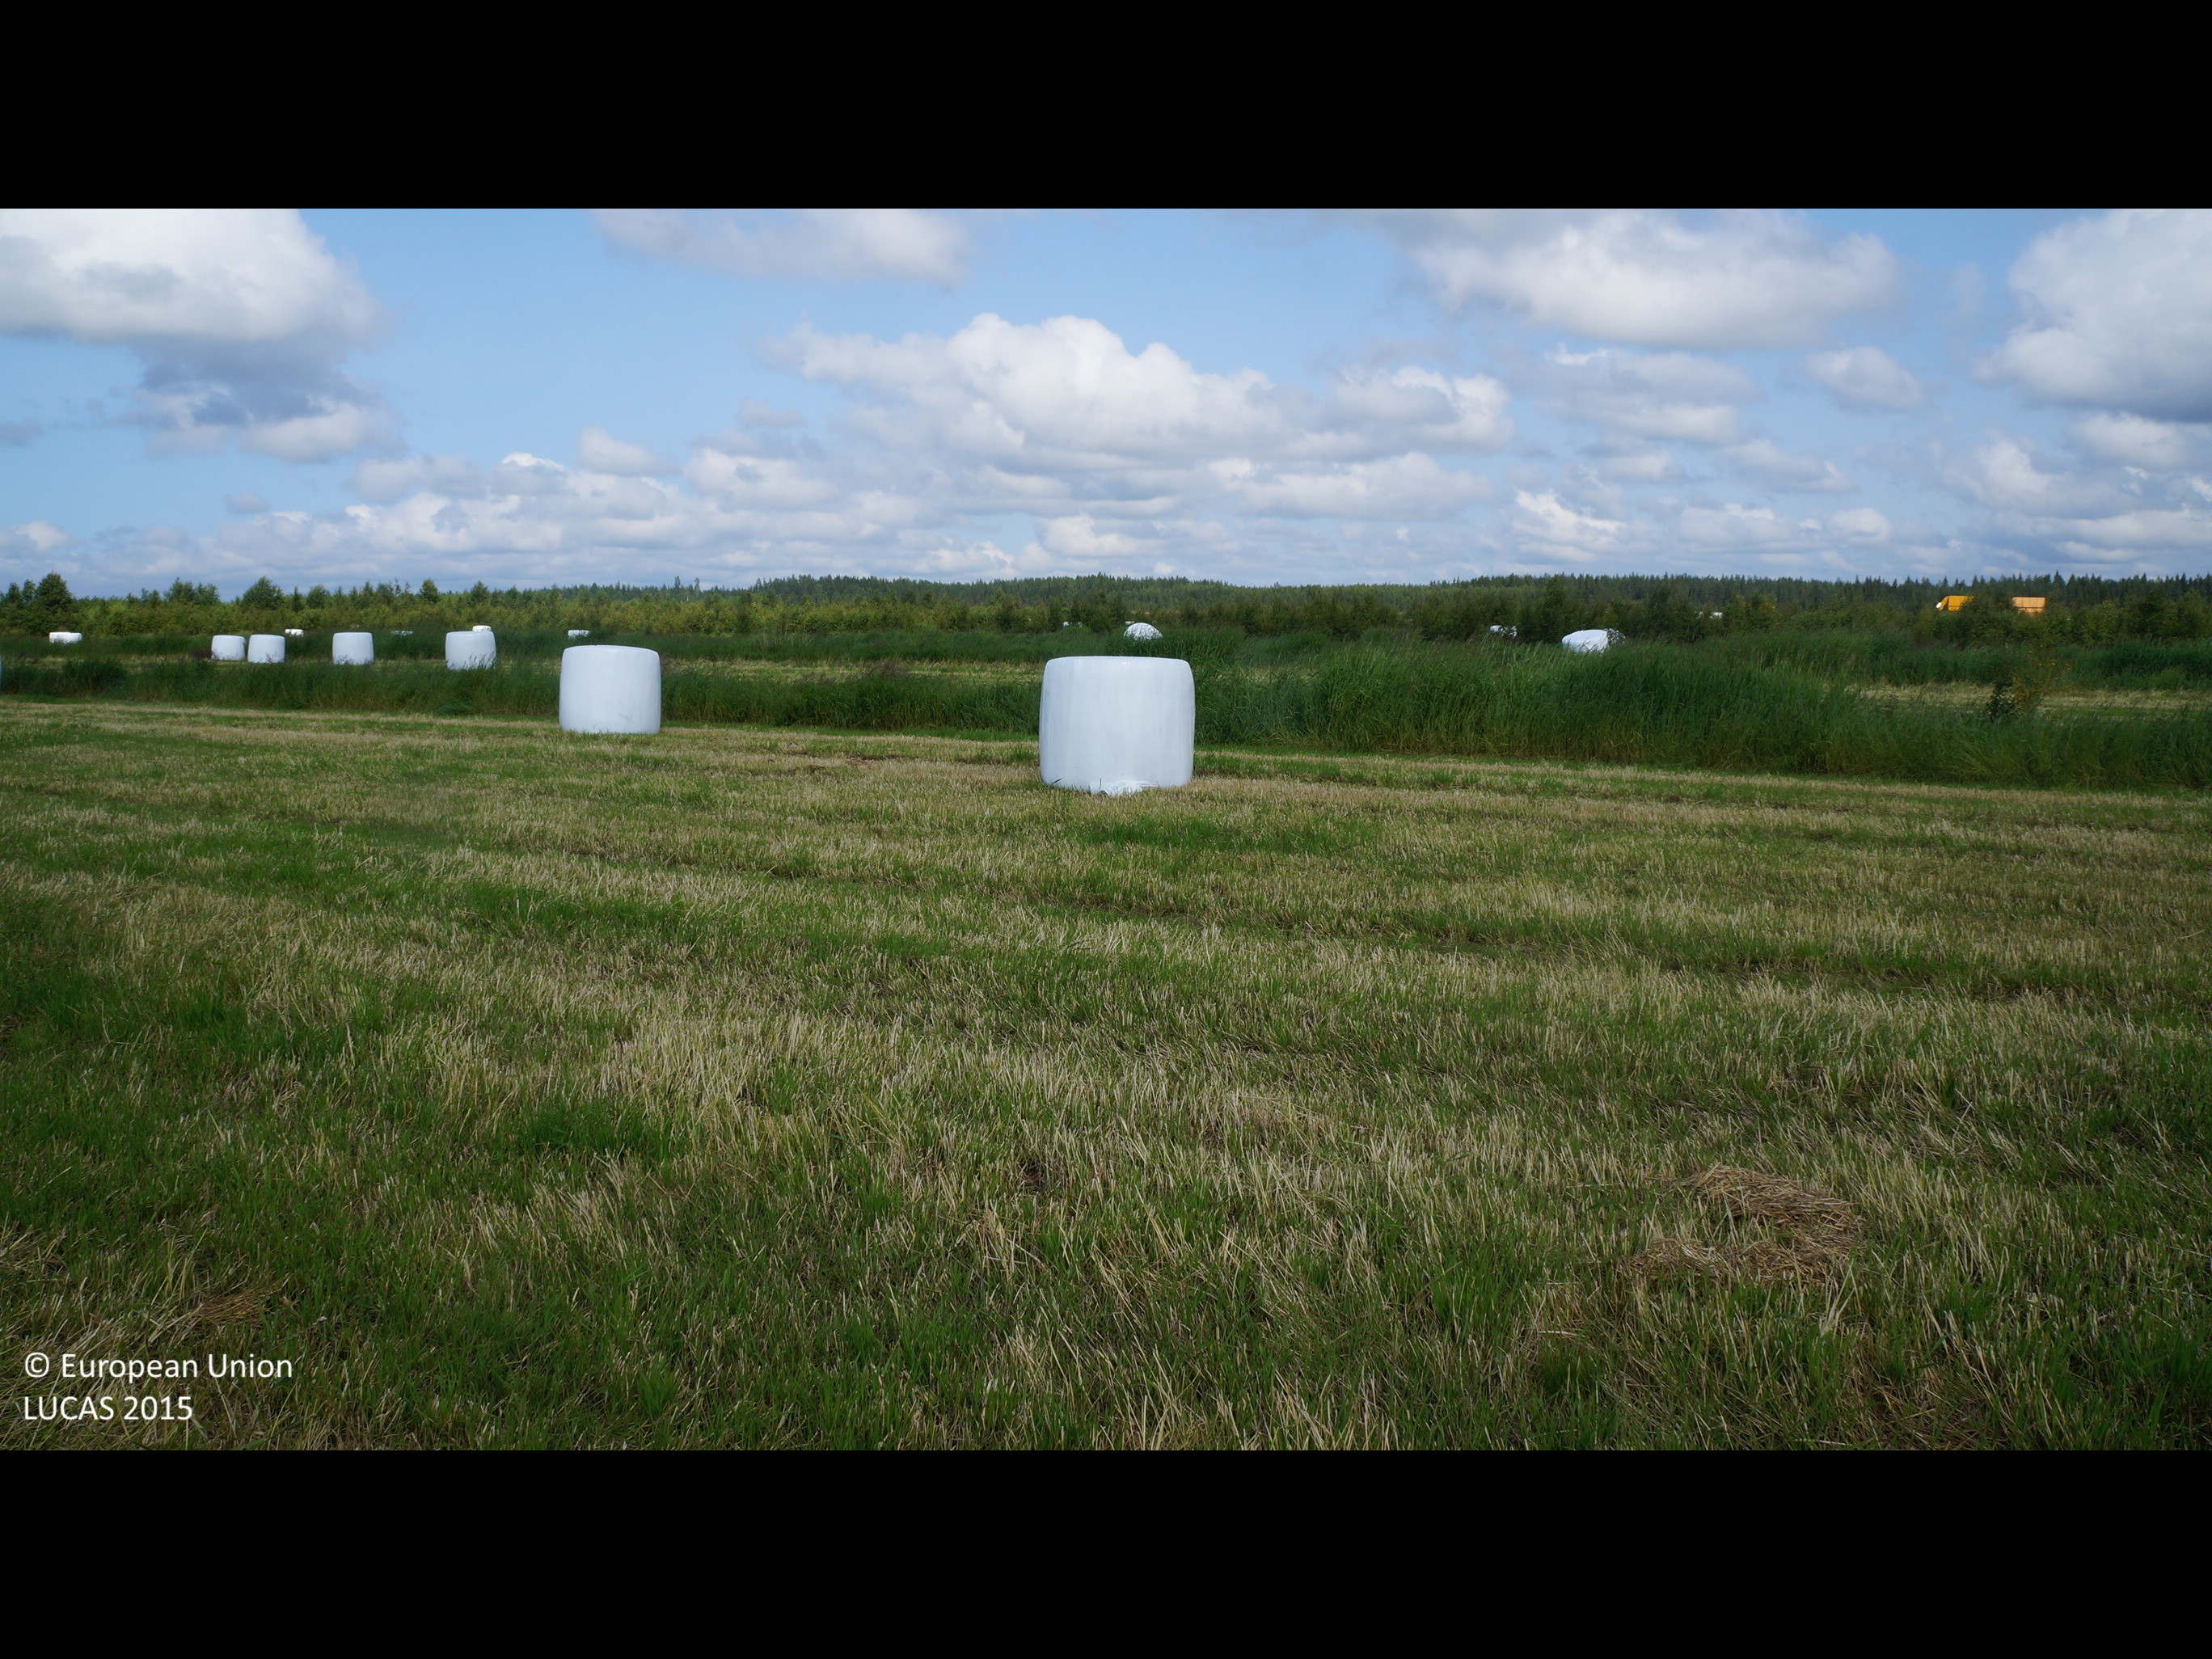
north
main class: Cropland
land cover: Temporary grasslands
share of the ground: > 75 %
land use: Agriculture (excluding fallow land and kitchen gardens)
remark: Harvested field
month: July
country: FI
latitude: 64.1601
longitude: 24.4039
